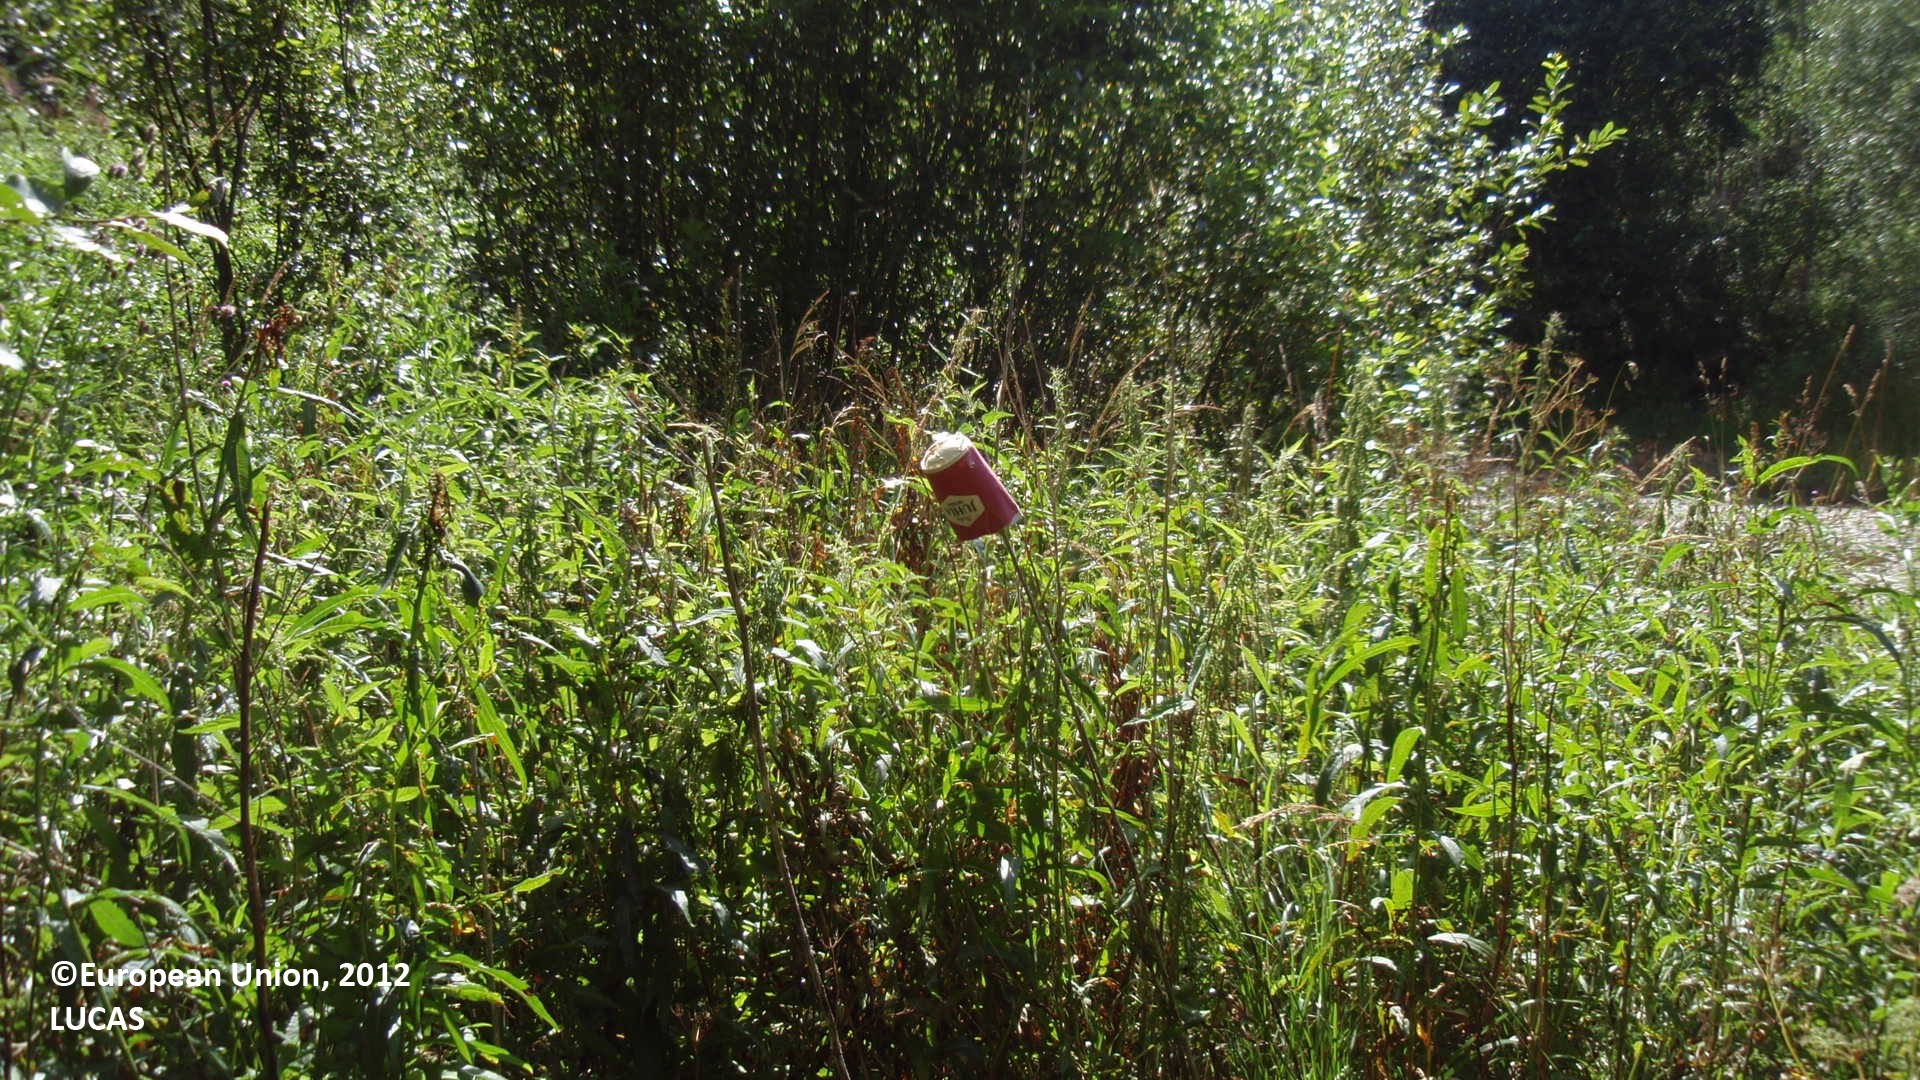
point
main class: Shrubland
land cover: Shrubland with sparse tree cover
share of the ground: > 75 %
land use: Forestry
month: August
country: FI
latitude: 61.0689
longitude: 28.6988
